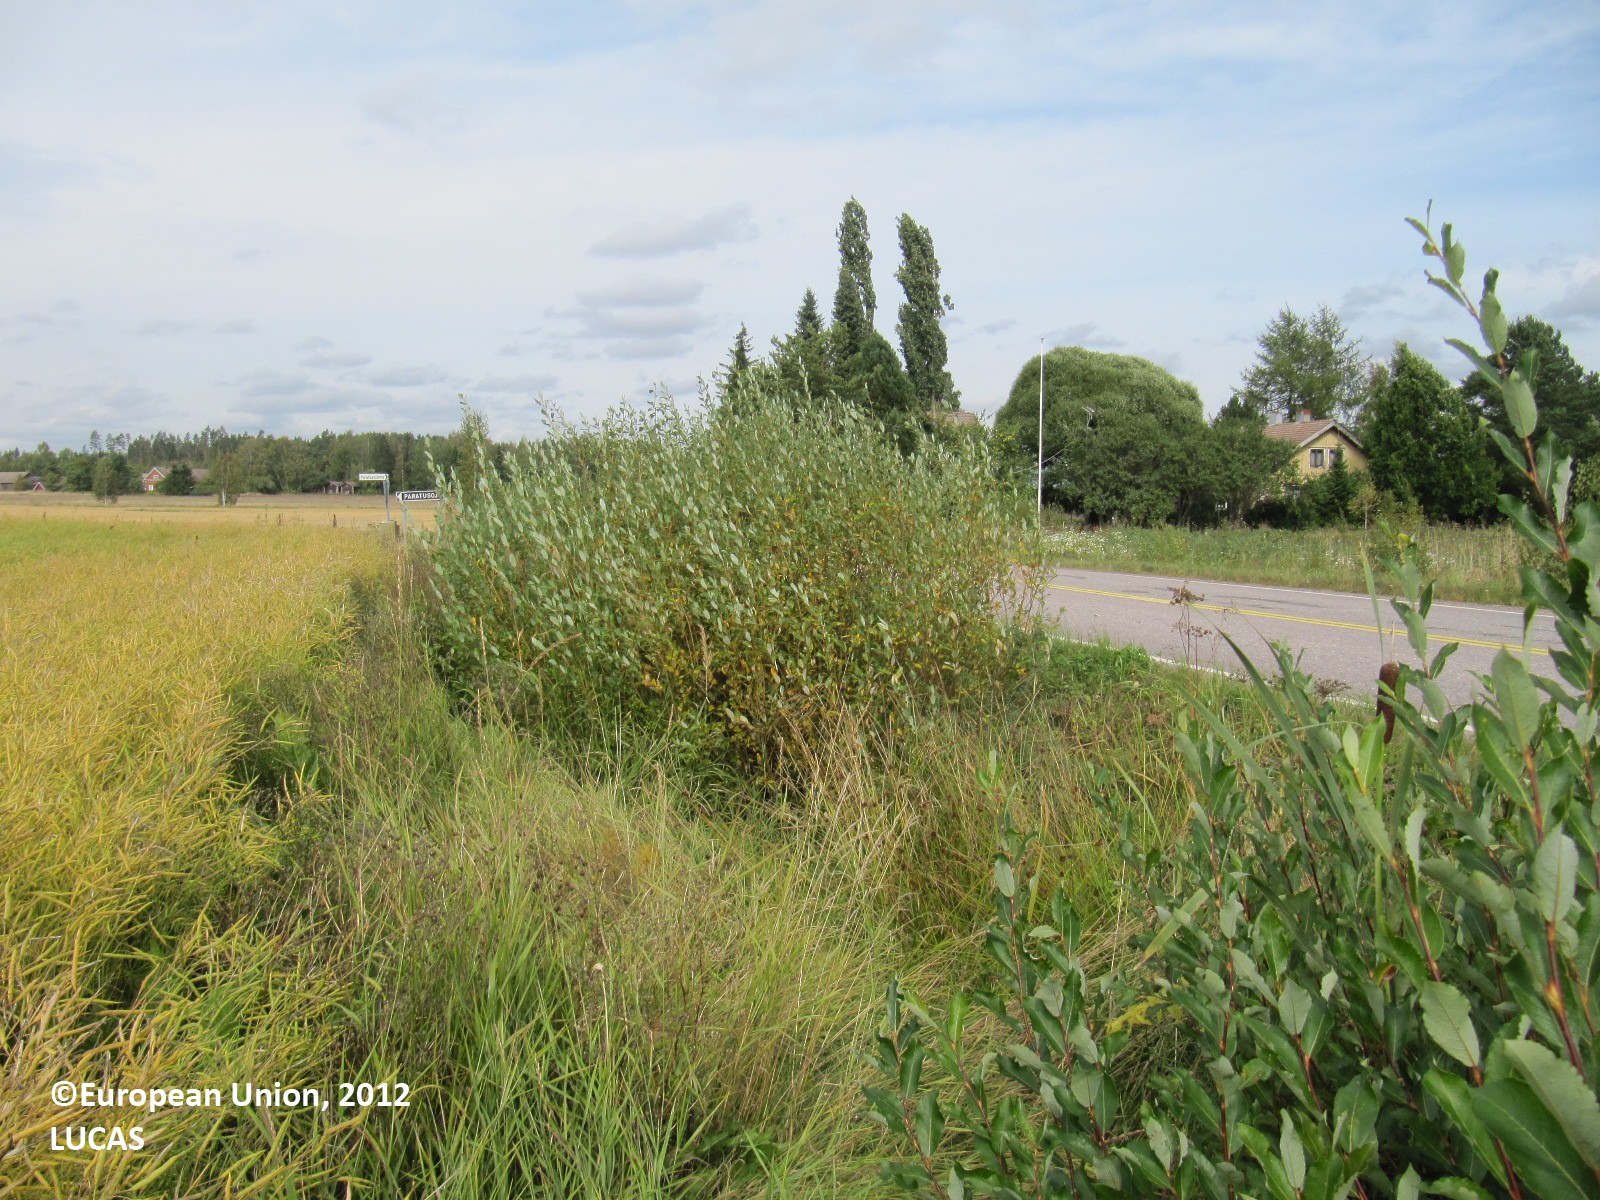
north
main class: Cropland
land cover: Rape and turnip rape
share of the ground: > 75 %
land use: Agriculture (excluding fallow land and kitchen gardens)
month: August
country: FI
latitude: 60.9237
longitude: 22.8564
